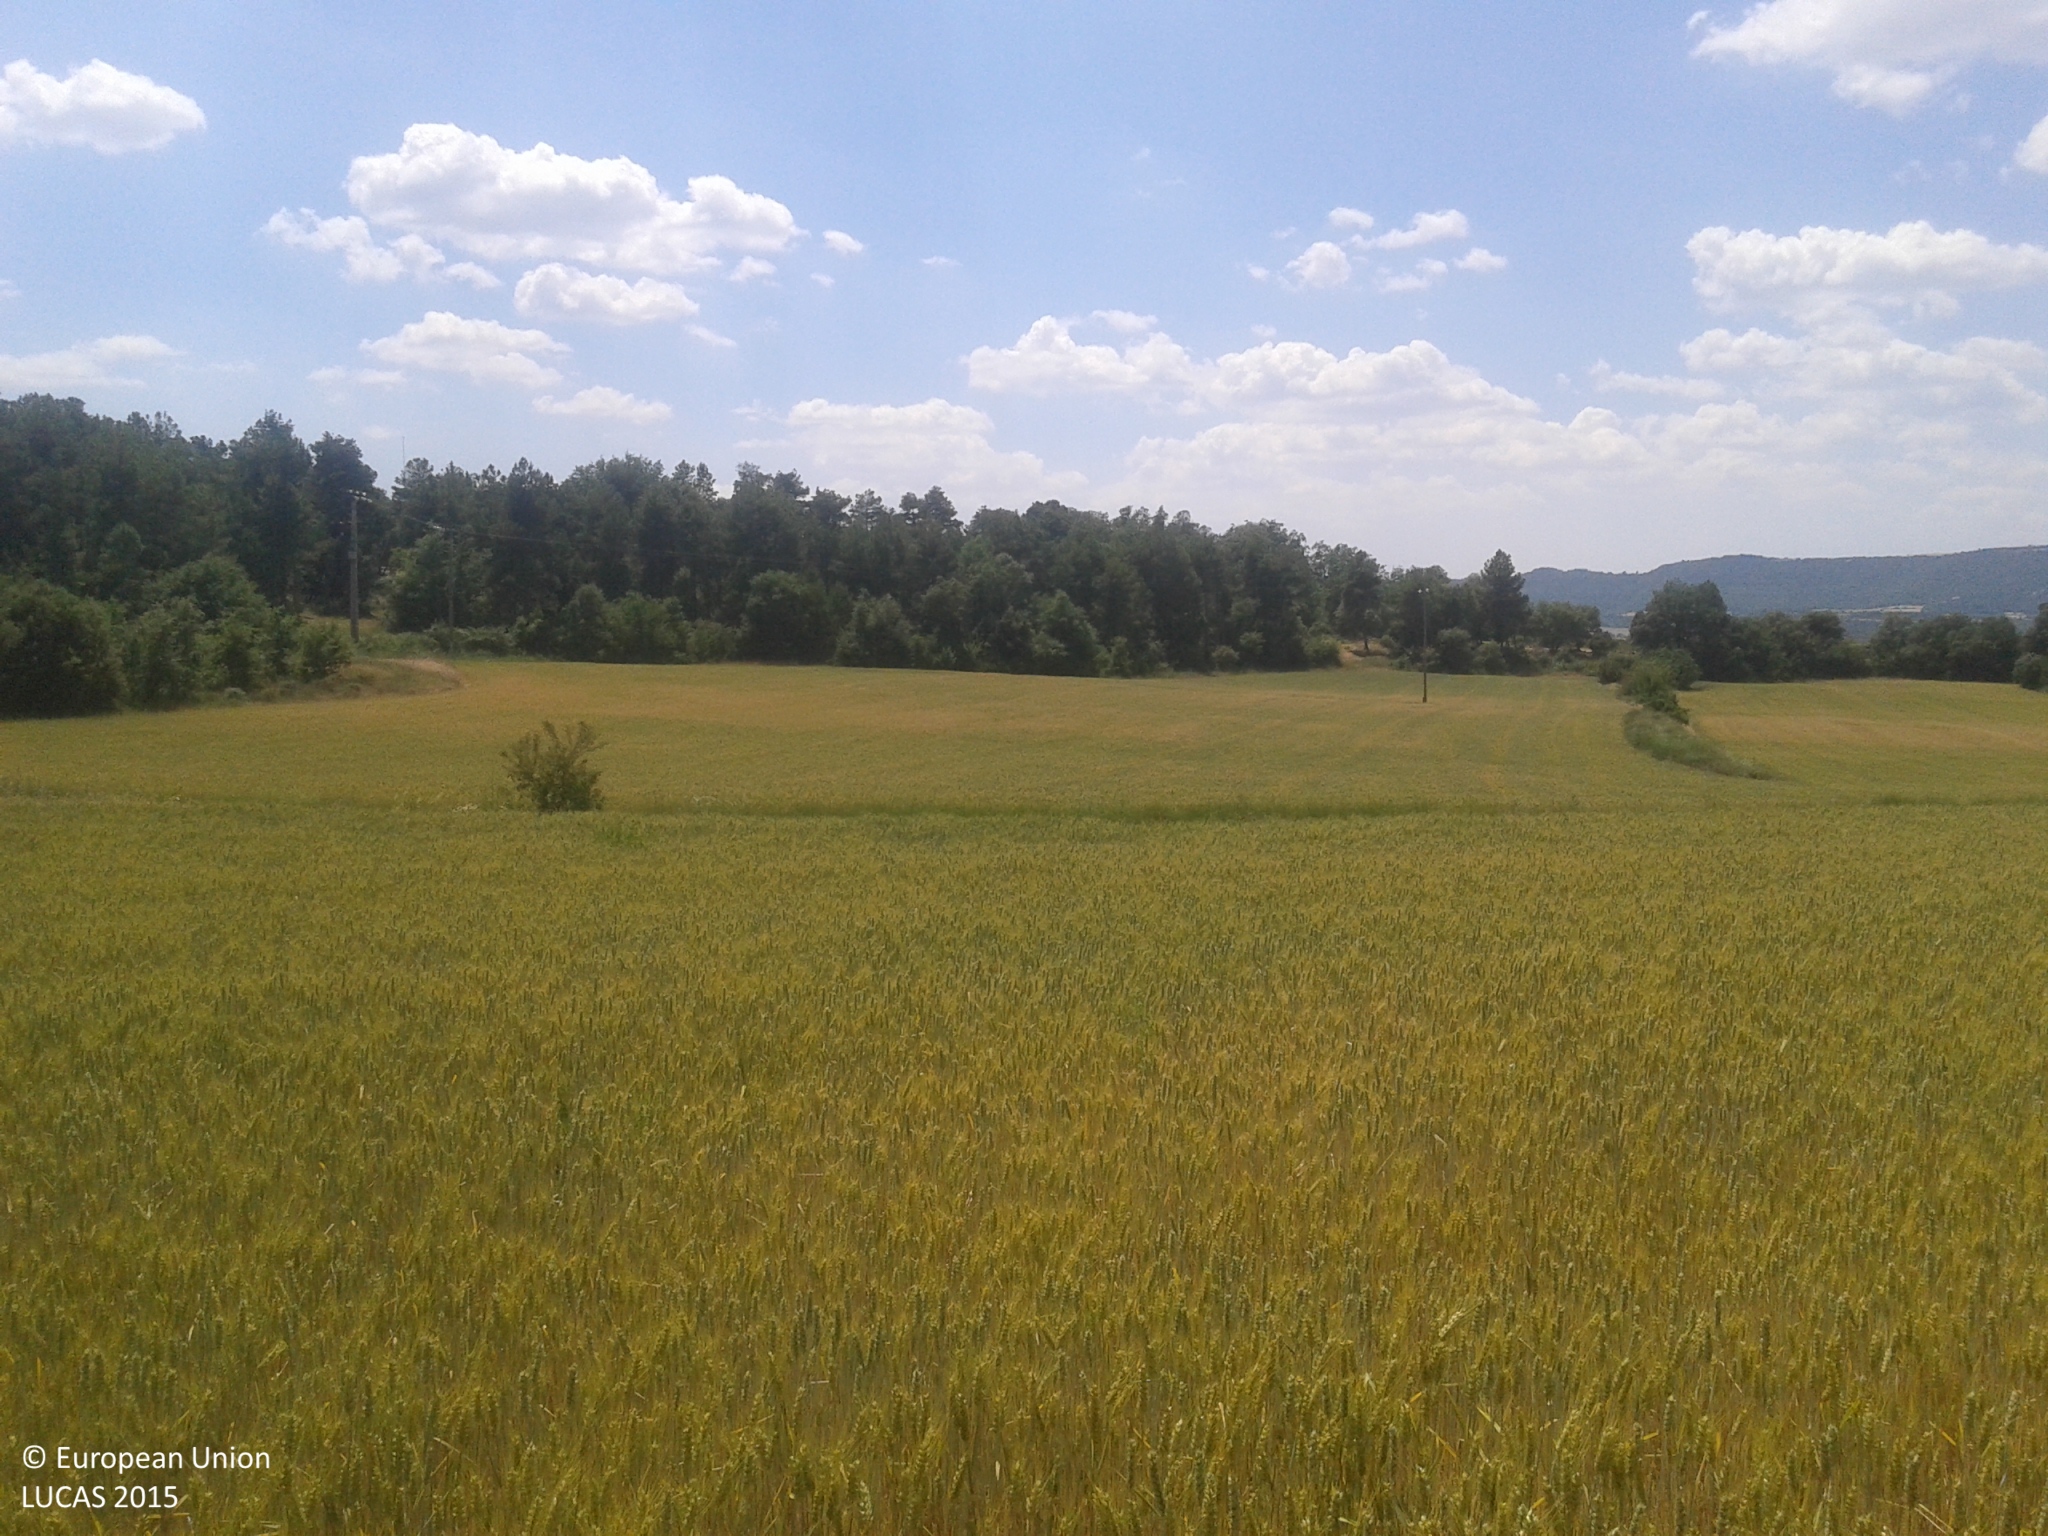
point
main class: Cropland
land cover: Common wheat
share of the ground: > 75 %
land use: Agriculture (excluding fallow land and kitchen gardens)
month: June
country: ES
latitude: 41.9739
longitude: 1.5532
